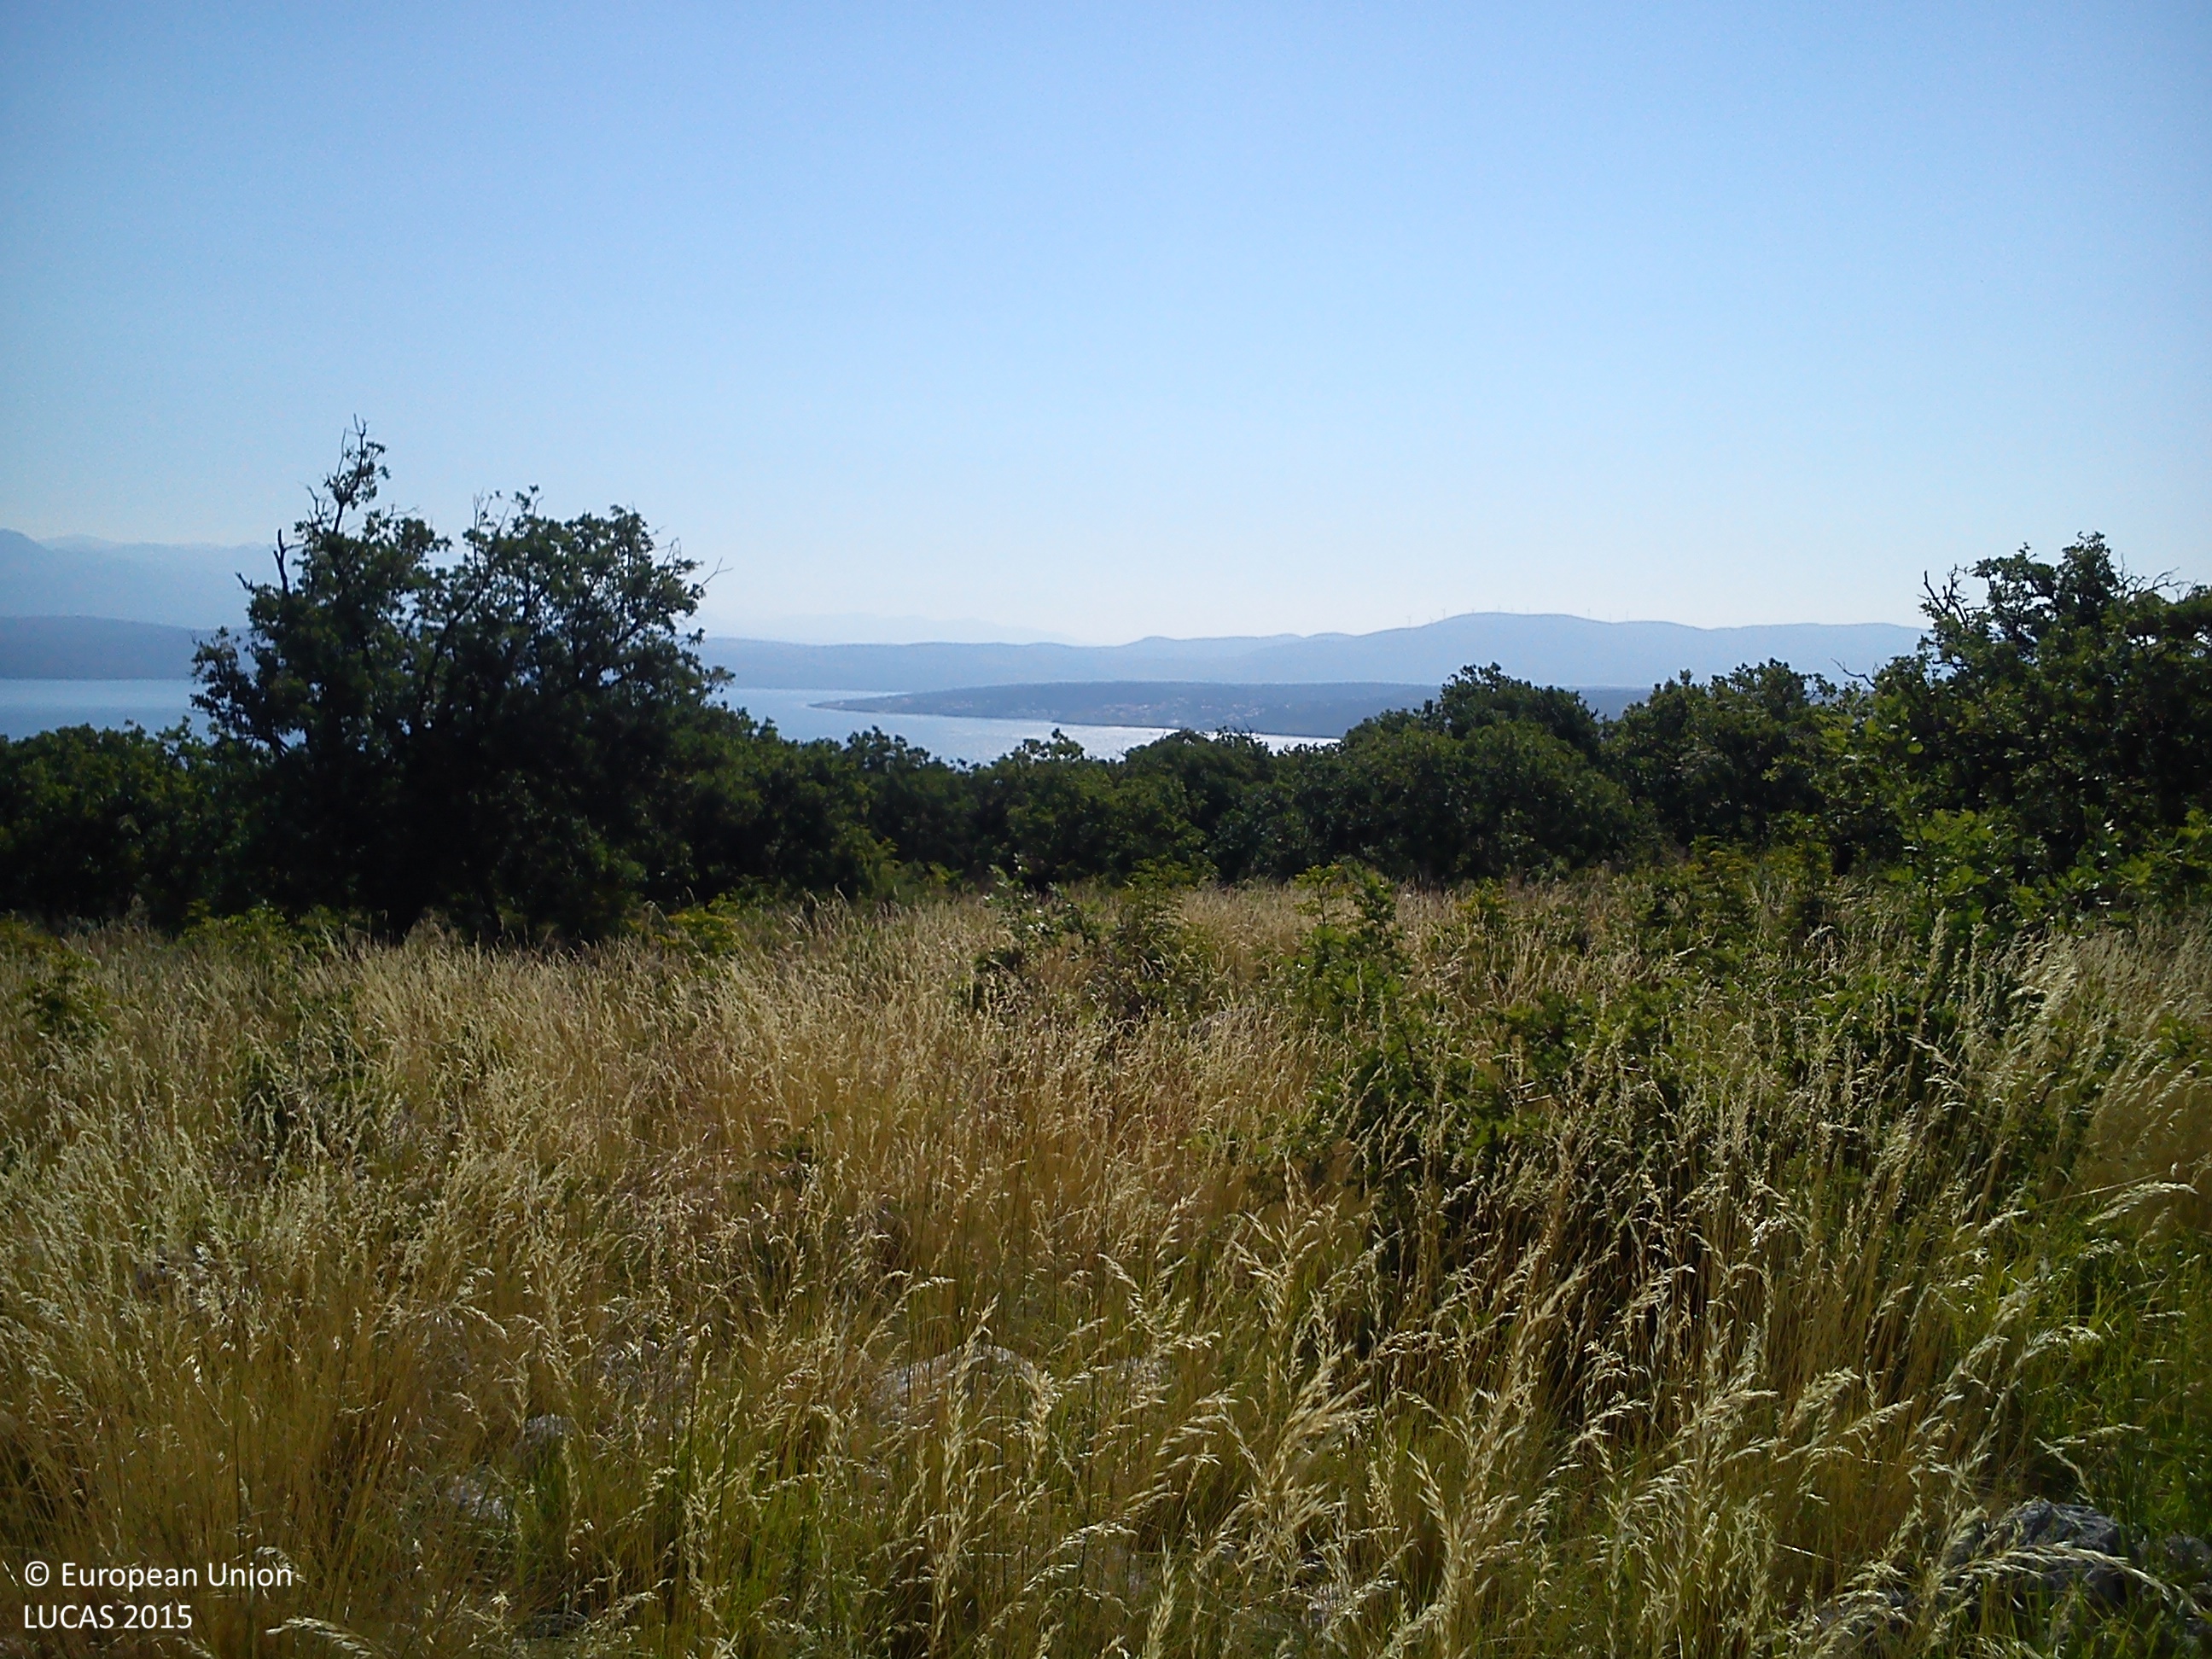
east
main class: Grassland
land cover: Grassland with sparse tree/shrub cover
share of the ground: > 75 %
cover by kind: herbaceous plants 60 %, unconsolidated bare surface 25 %, shrubs 10 %, coniferous forest trees 5 %
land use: Semi-natural and natural areas not in use
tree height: < 5 m
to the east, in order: Grassland with sparse tree/shrub cover
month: June
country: HR
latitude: 44.1875
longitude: 15.4843
